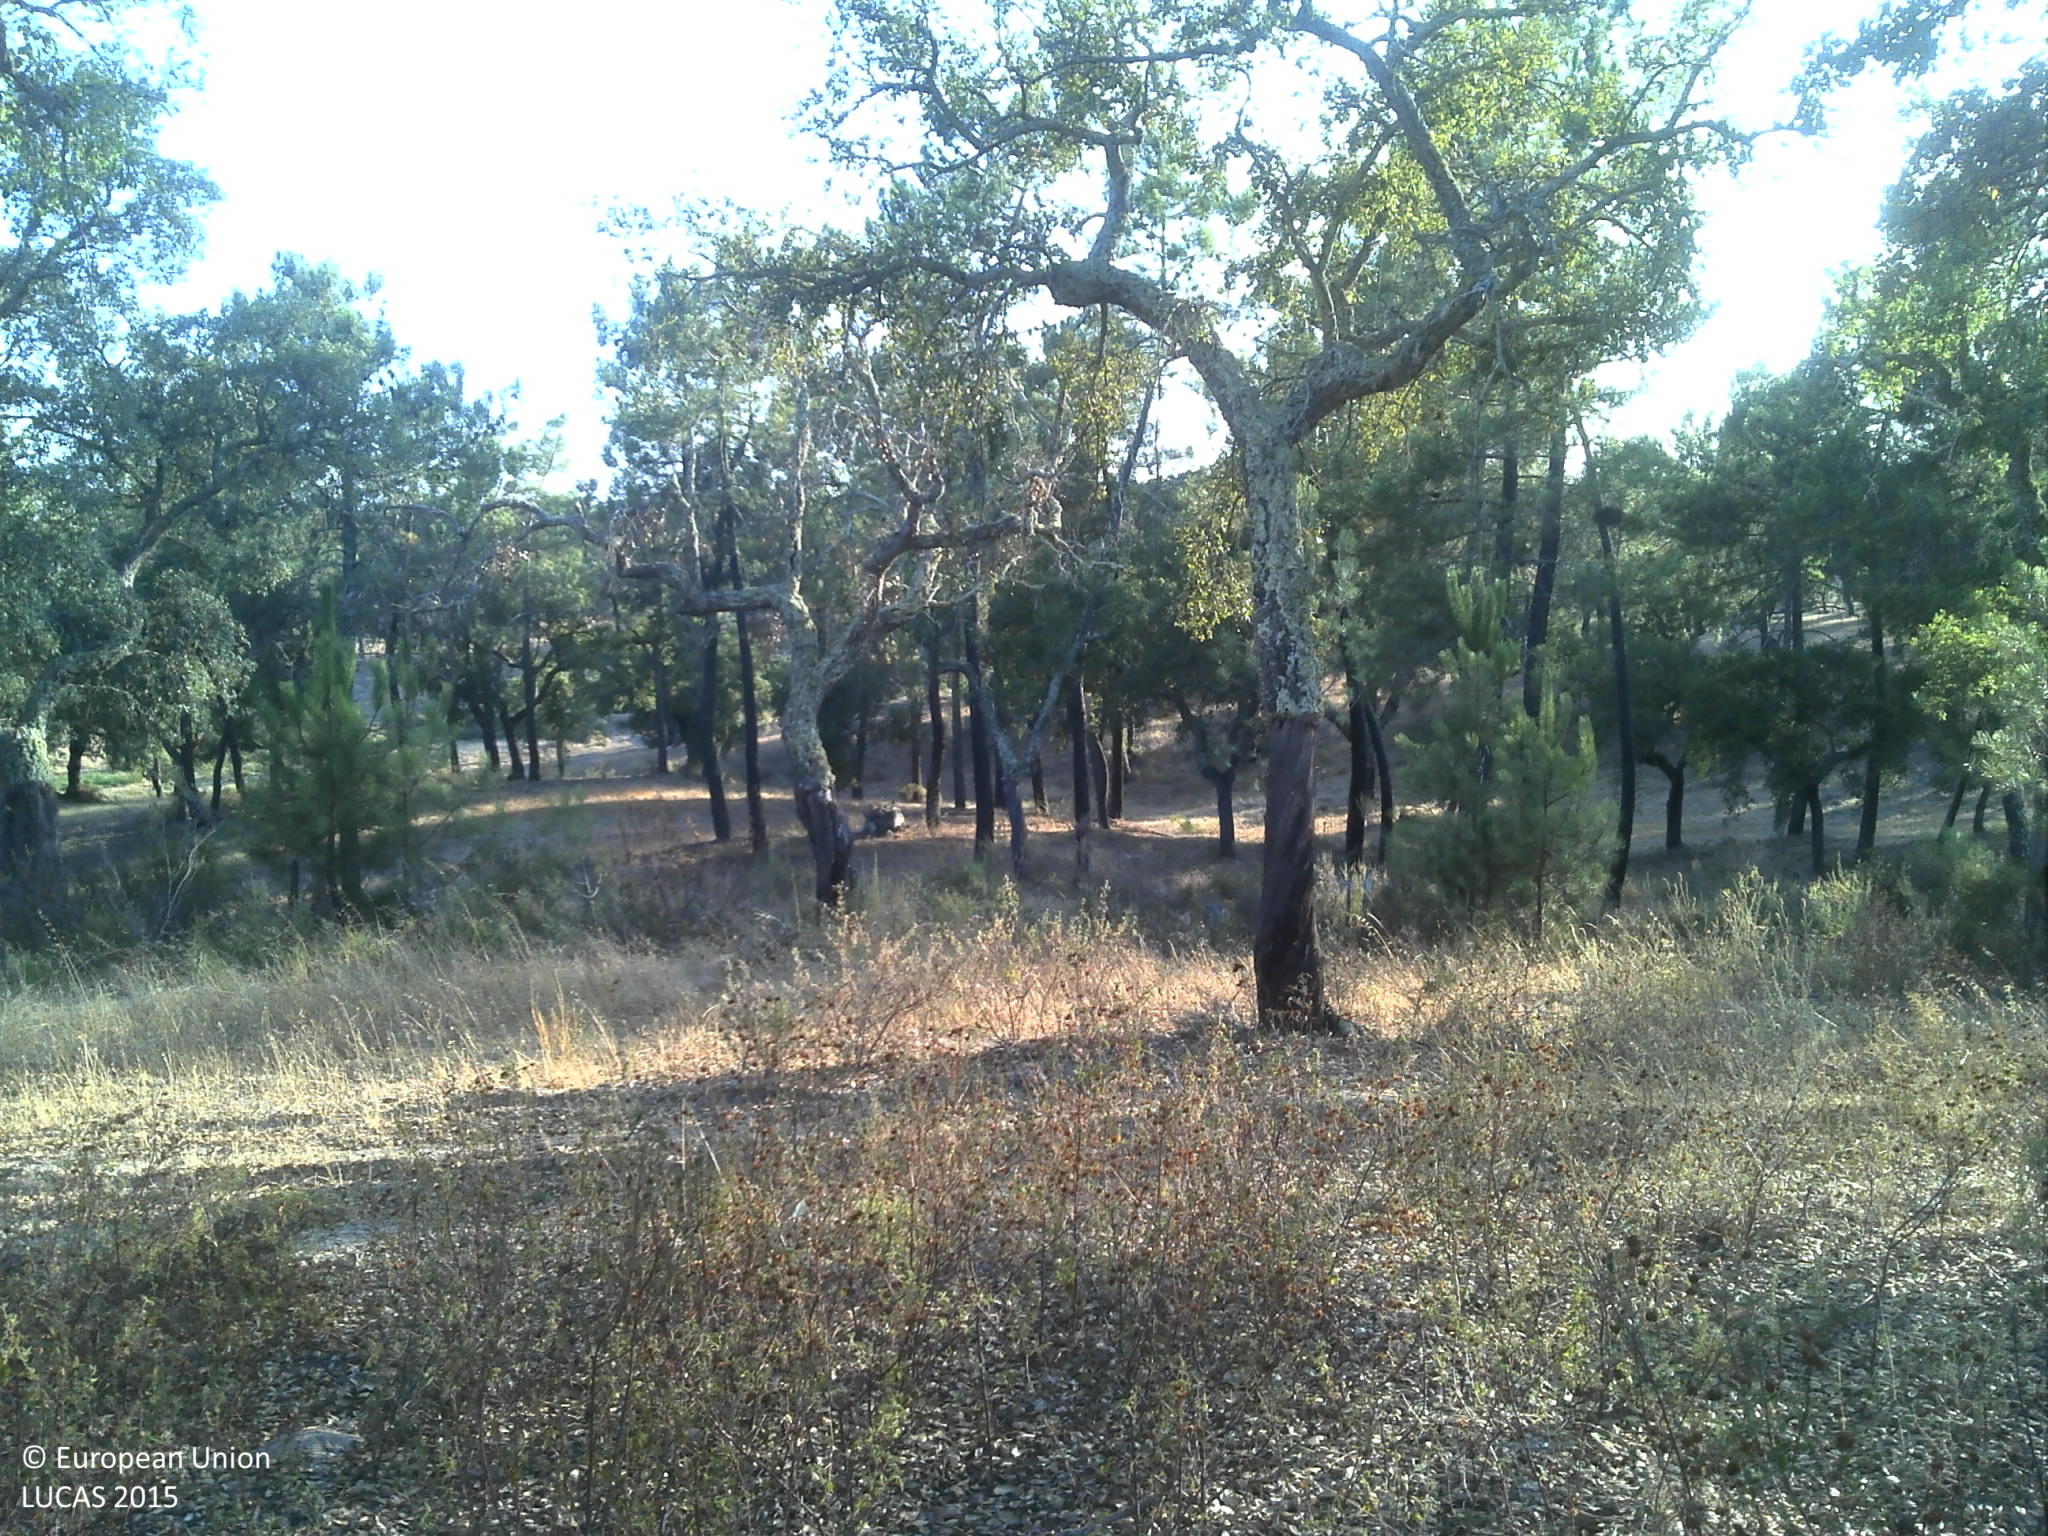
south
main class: Woodland
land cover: Broadleaved woodland
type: broadleaved evergreen forest
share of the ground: 25 - 50 %
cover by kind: broadleaved forest trees 50 %, unconsolidated bare surface 25 %, herbaceous plants 15 %, shrubs 10 %
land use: Forestry
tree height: > 5 m
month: July
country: PT
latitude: 38.9370
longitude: -8.2007
